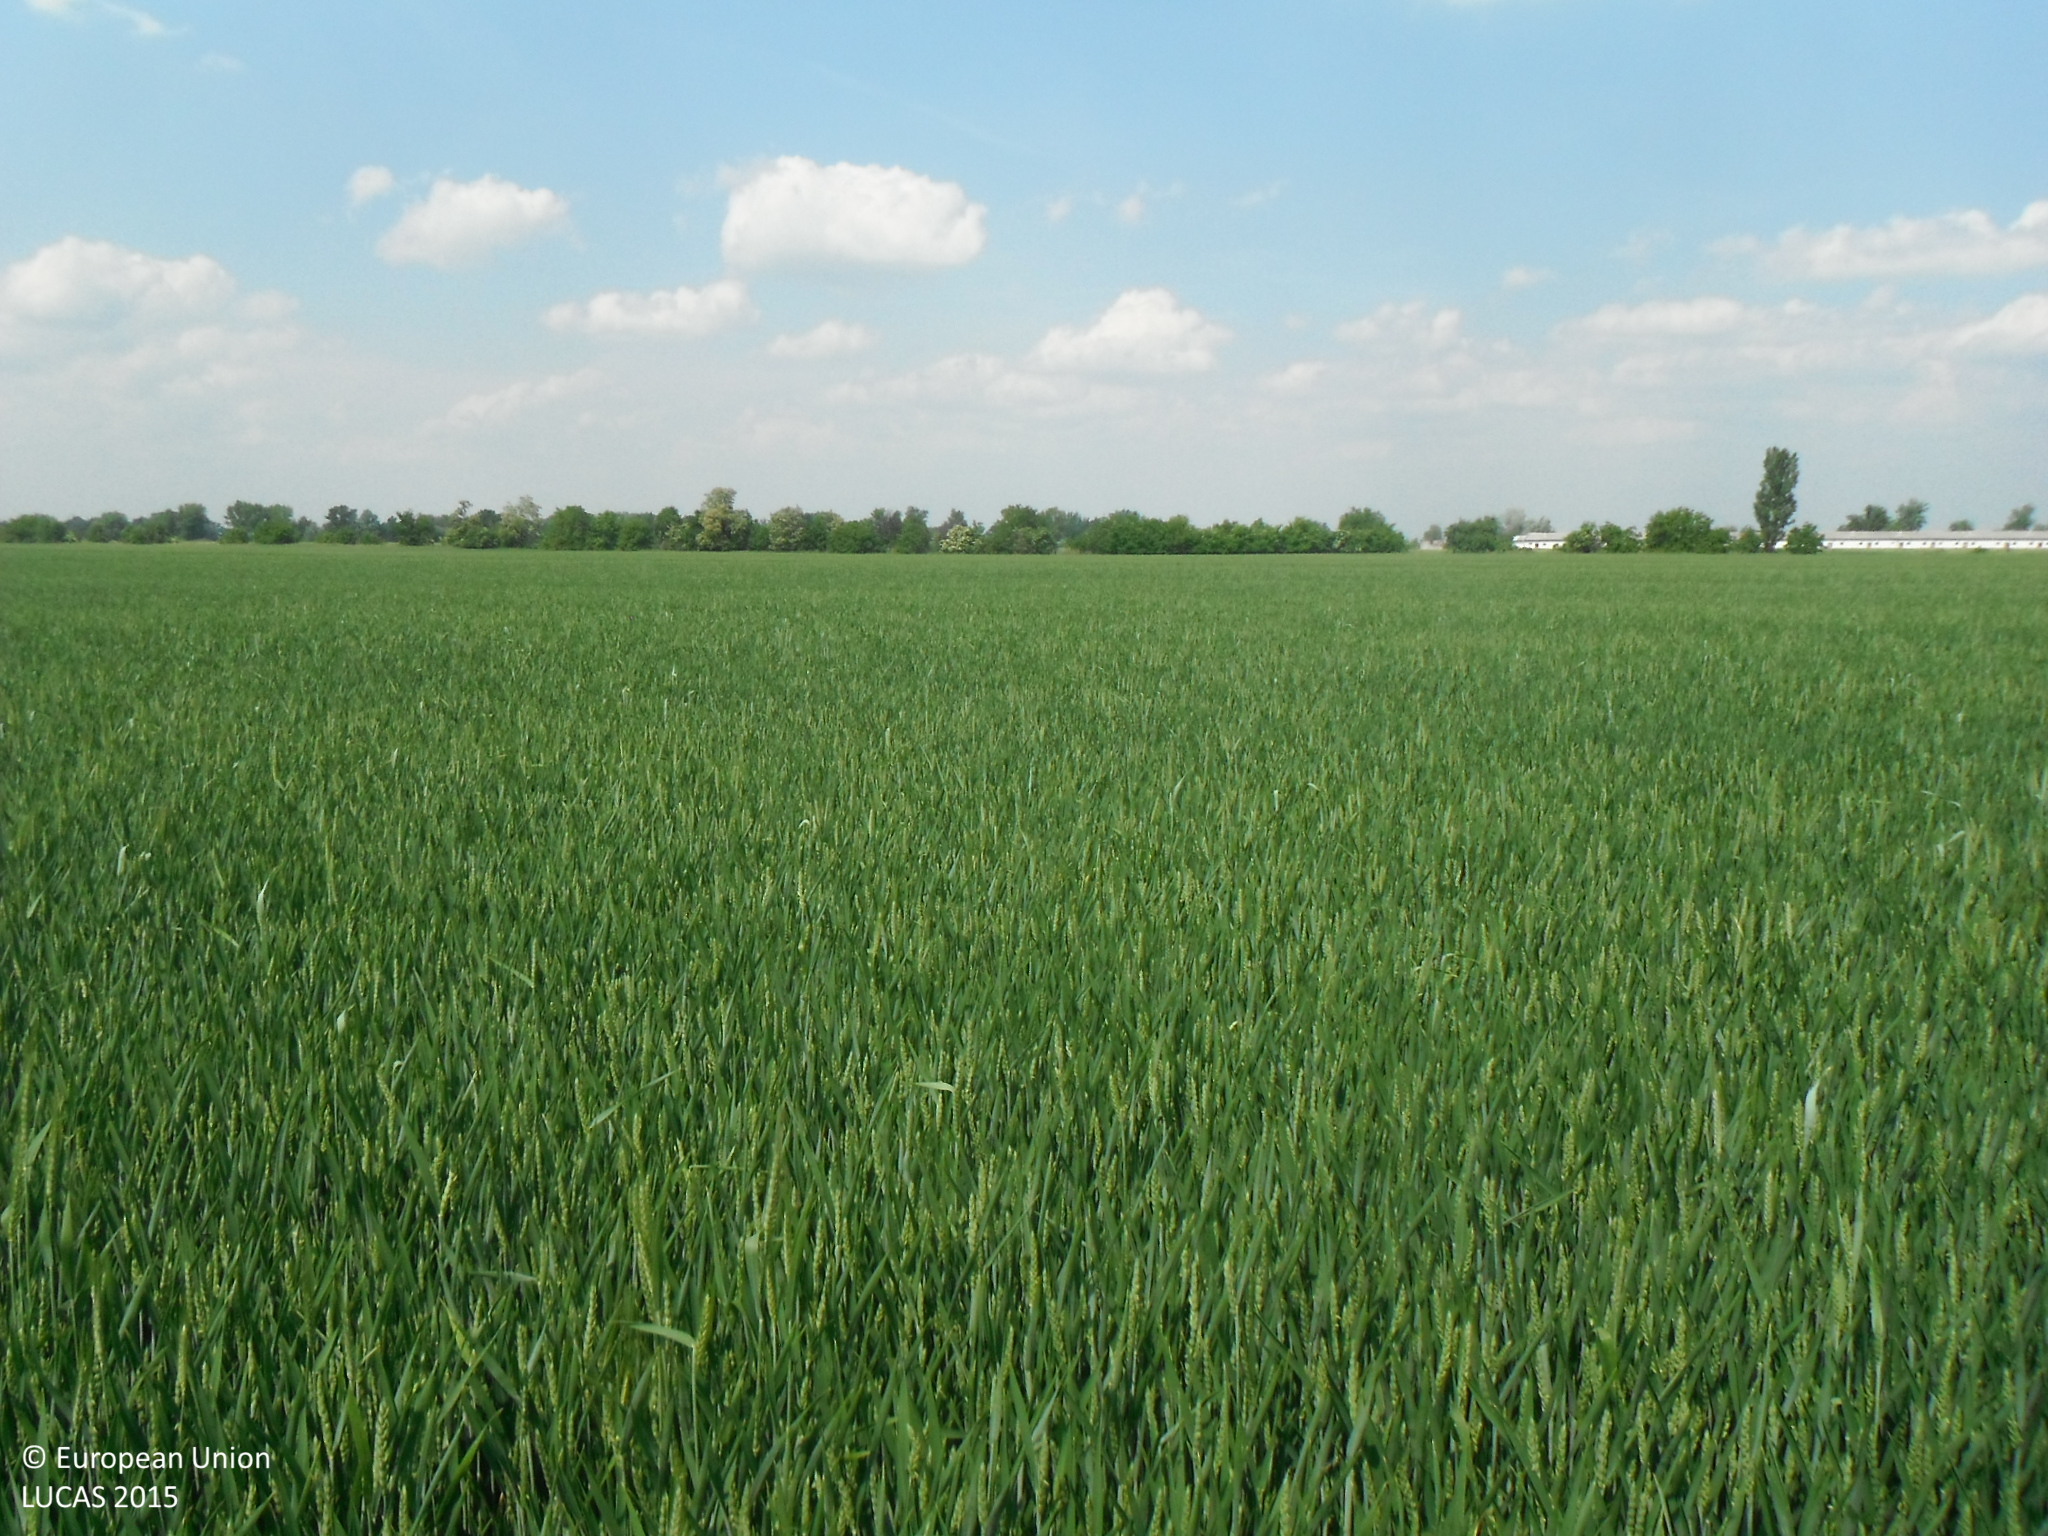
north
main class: Cropland
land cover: Common wheat
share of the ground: > 75 %
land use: Agriculture (excluding fallow land and kitchen gardens)
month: May
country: SK
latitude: 47.9514
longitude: 17.7367
